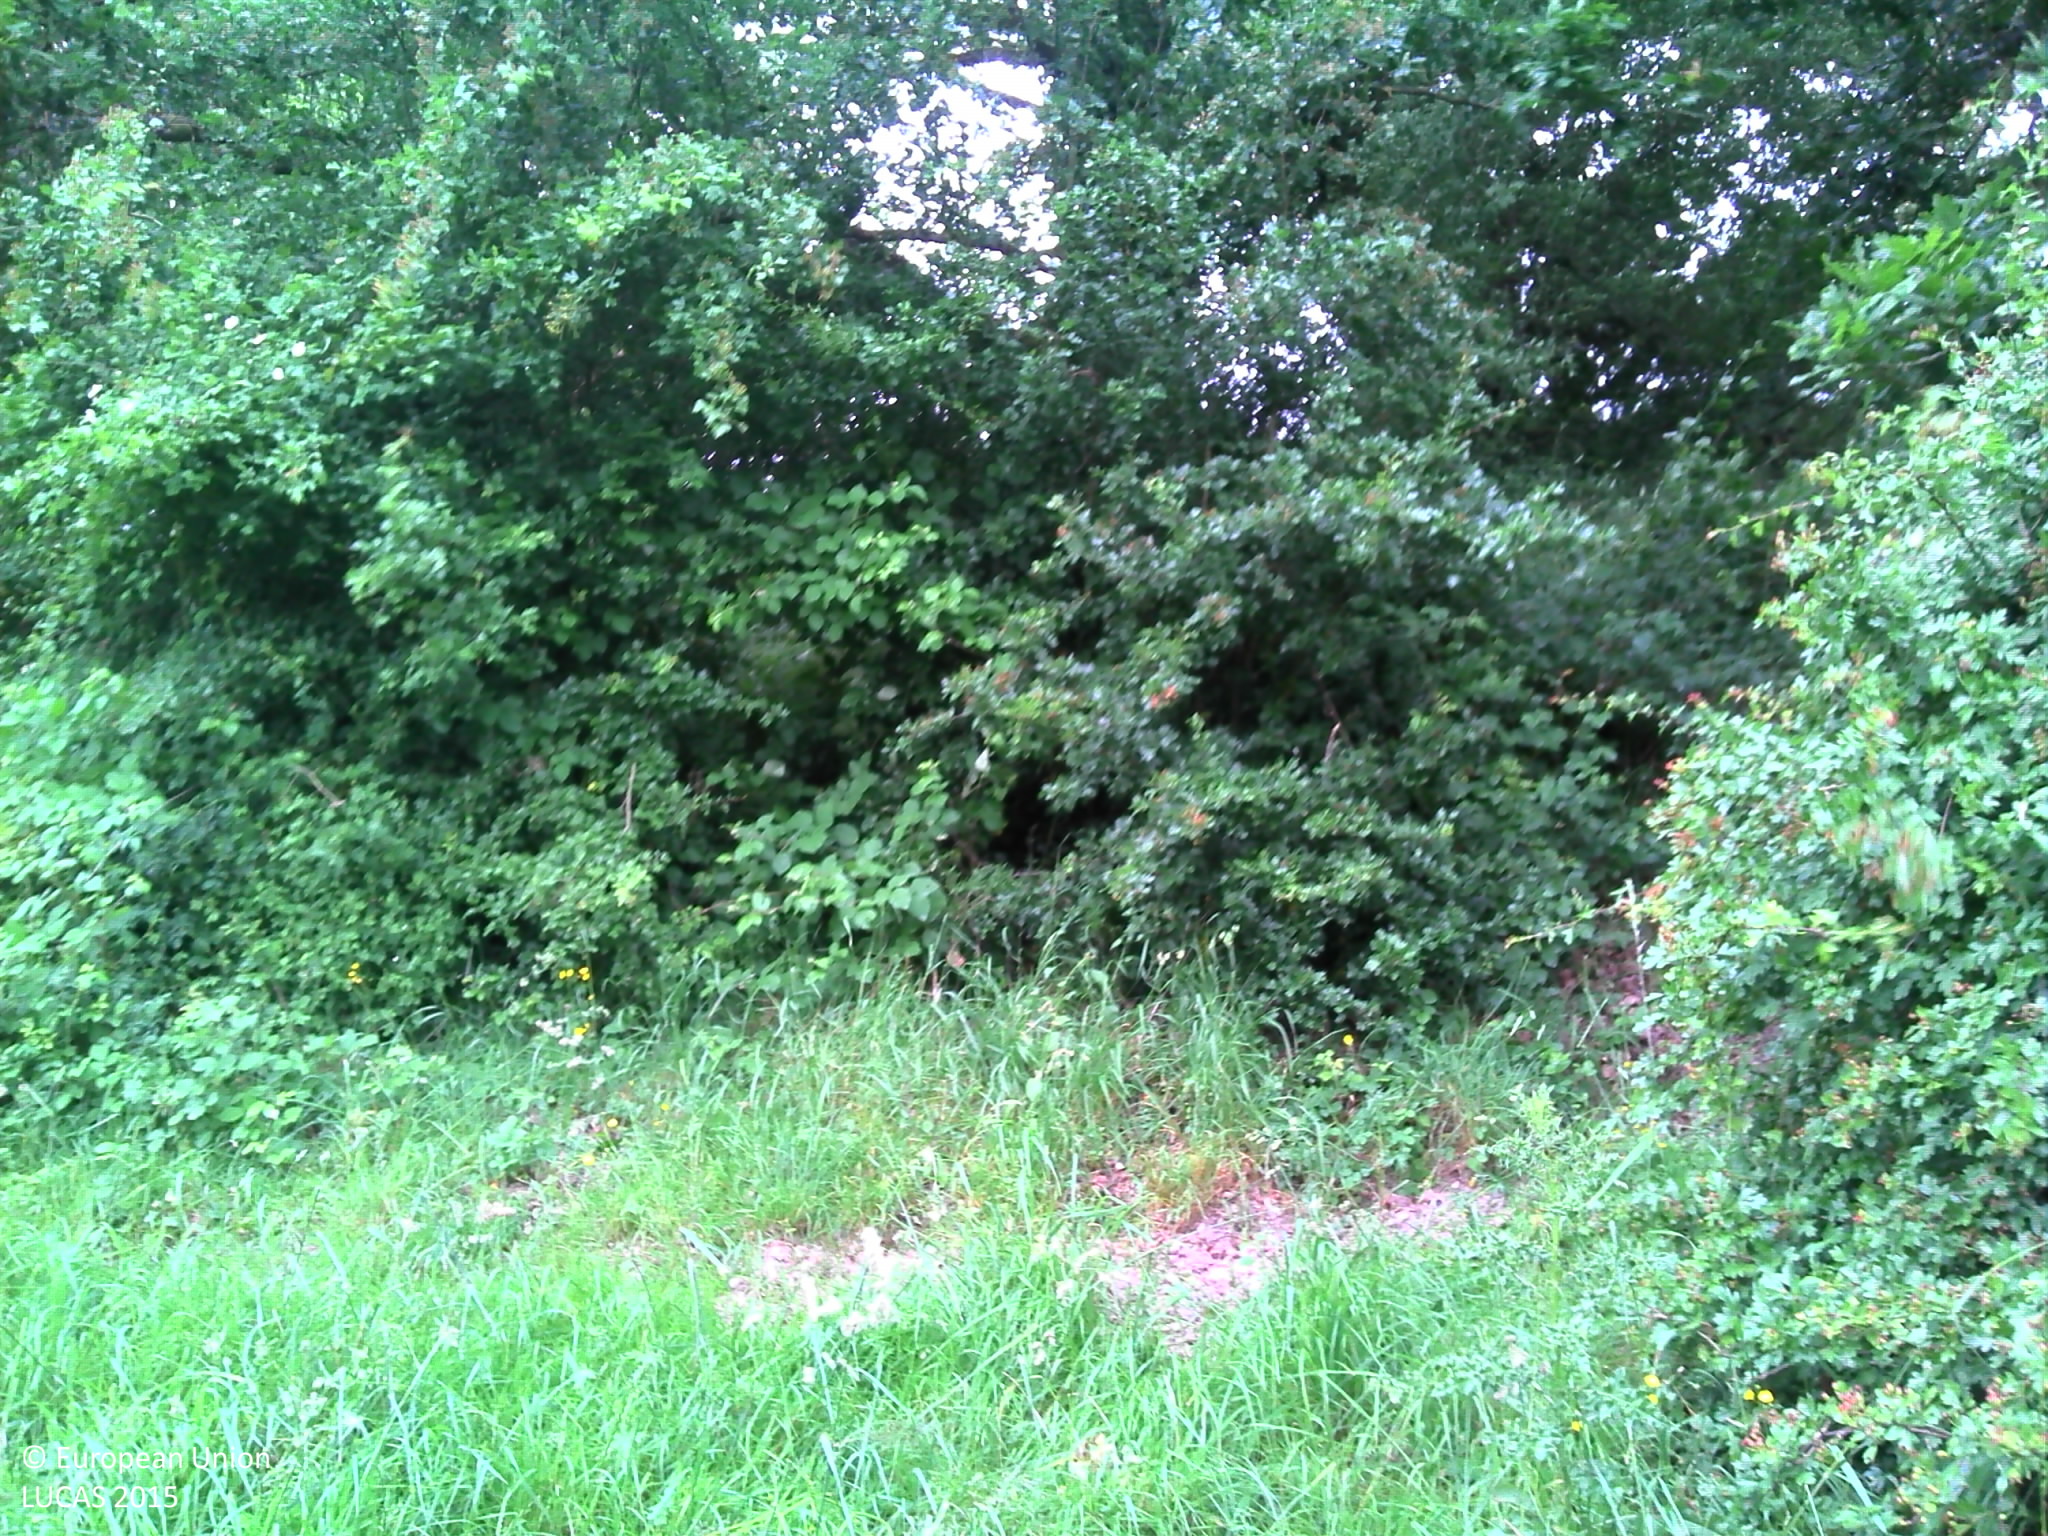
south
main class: Grassland
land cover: Grassland with sparse tree/shrub cover
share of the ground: > 75 %
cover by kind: herbaceous plants 95 %, broadleaved forest trees 5 %
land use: Agriculture (excluding fallow land and kitchen gardens)
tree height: > 5 m
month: June
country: FR
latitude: 48.2717
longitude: -0.0400
